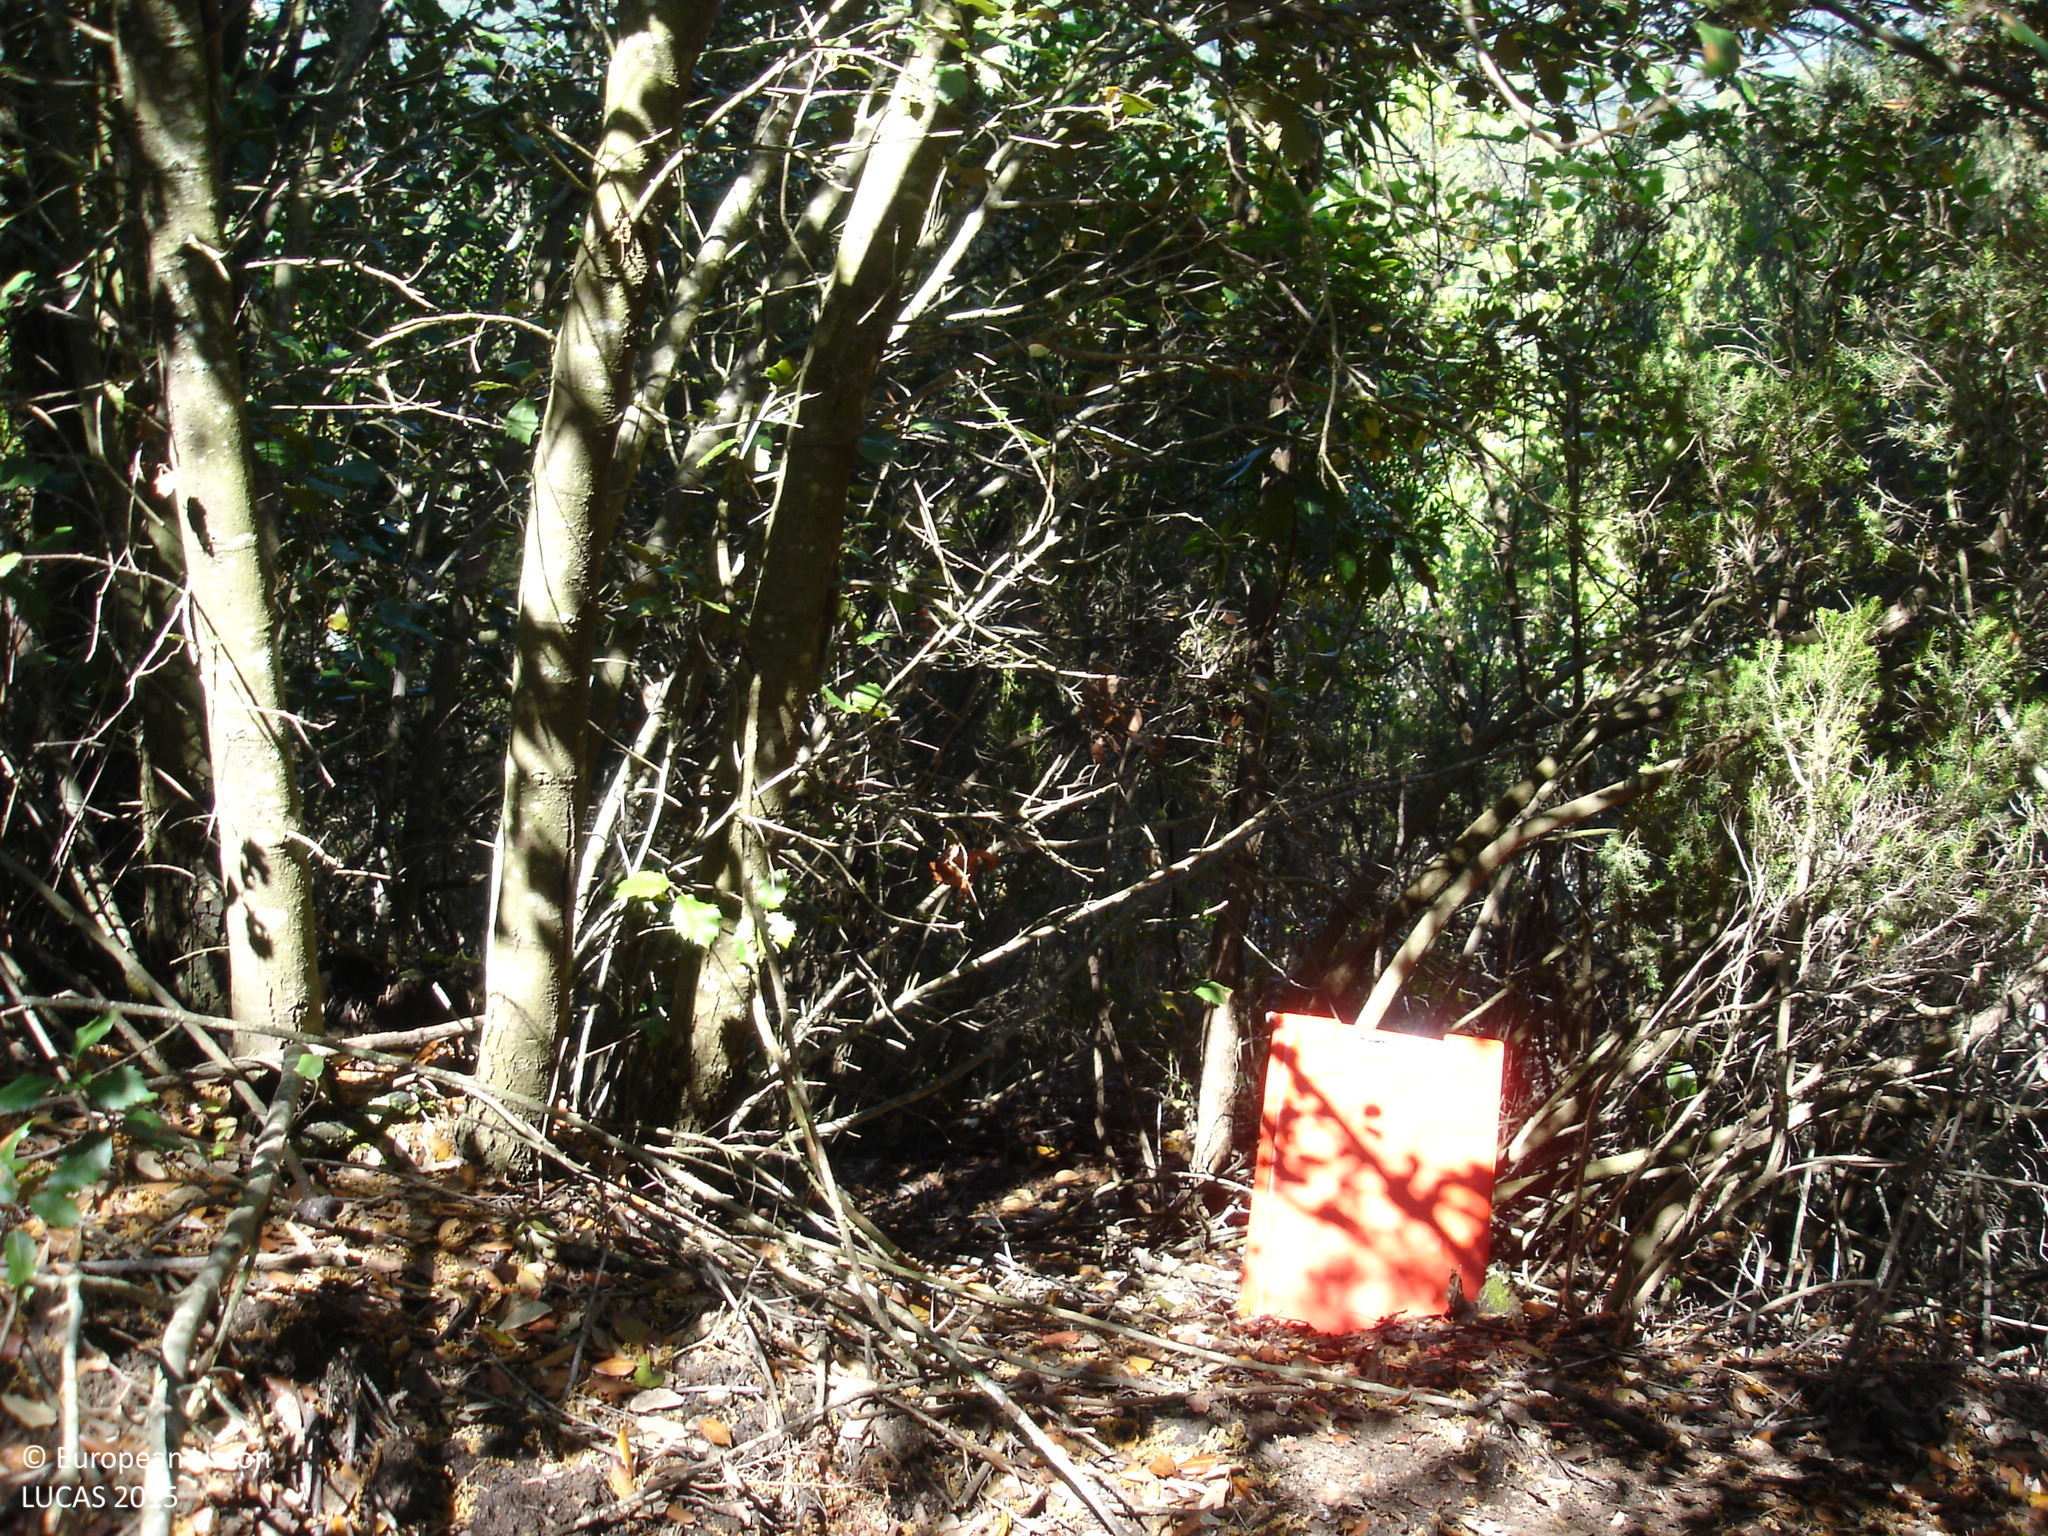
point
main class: Woodland
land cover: Broadleaved woodland
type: thermophilous deciduous forest
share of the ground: > 75 %
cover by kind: broadleaved forest trees 75 %, herbaceous plants 25 %
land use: Forestry
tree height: > 5 m
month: June
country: ES
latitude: 41.7662
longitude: 2.5947
